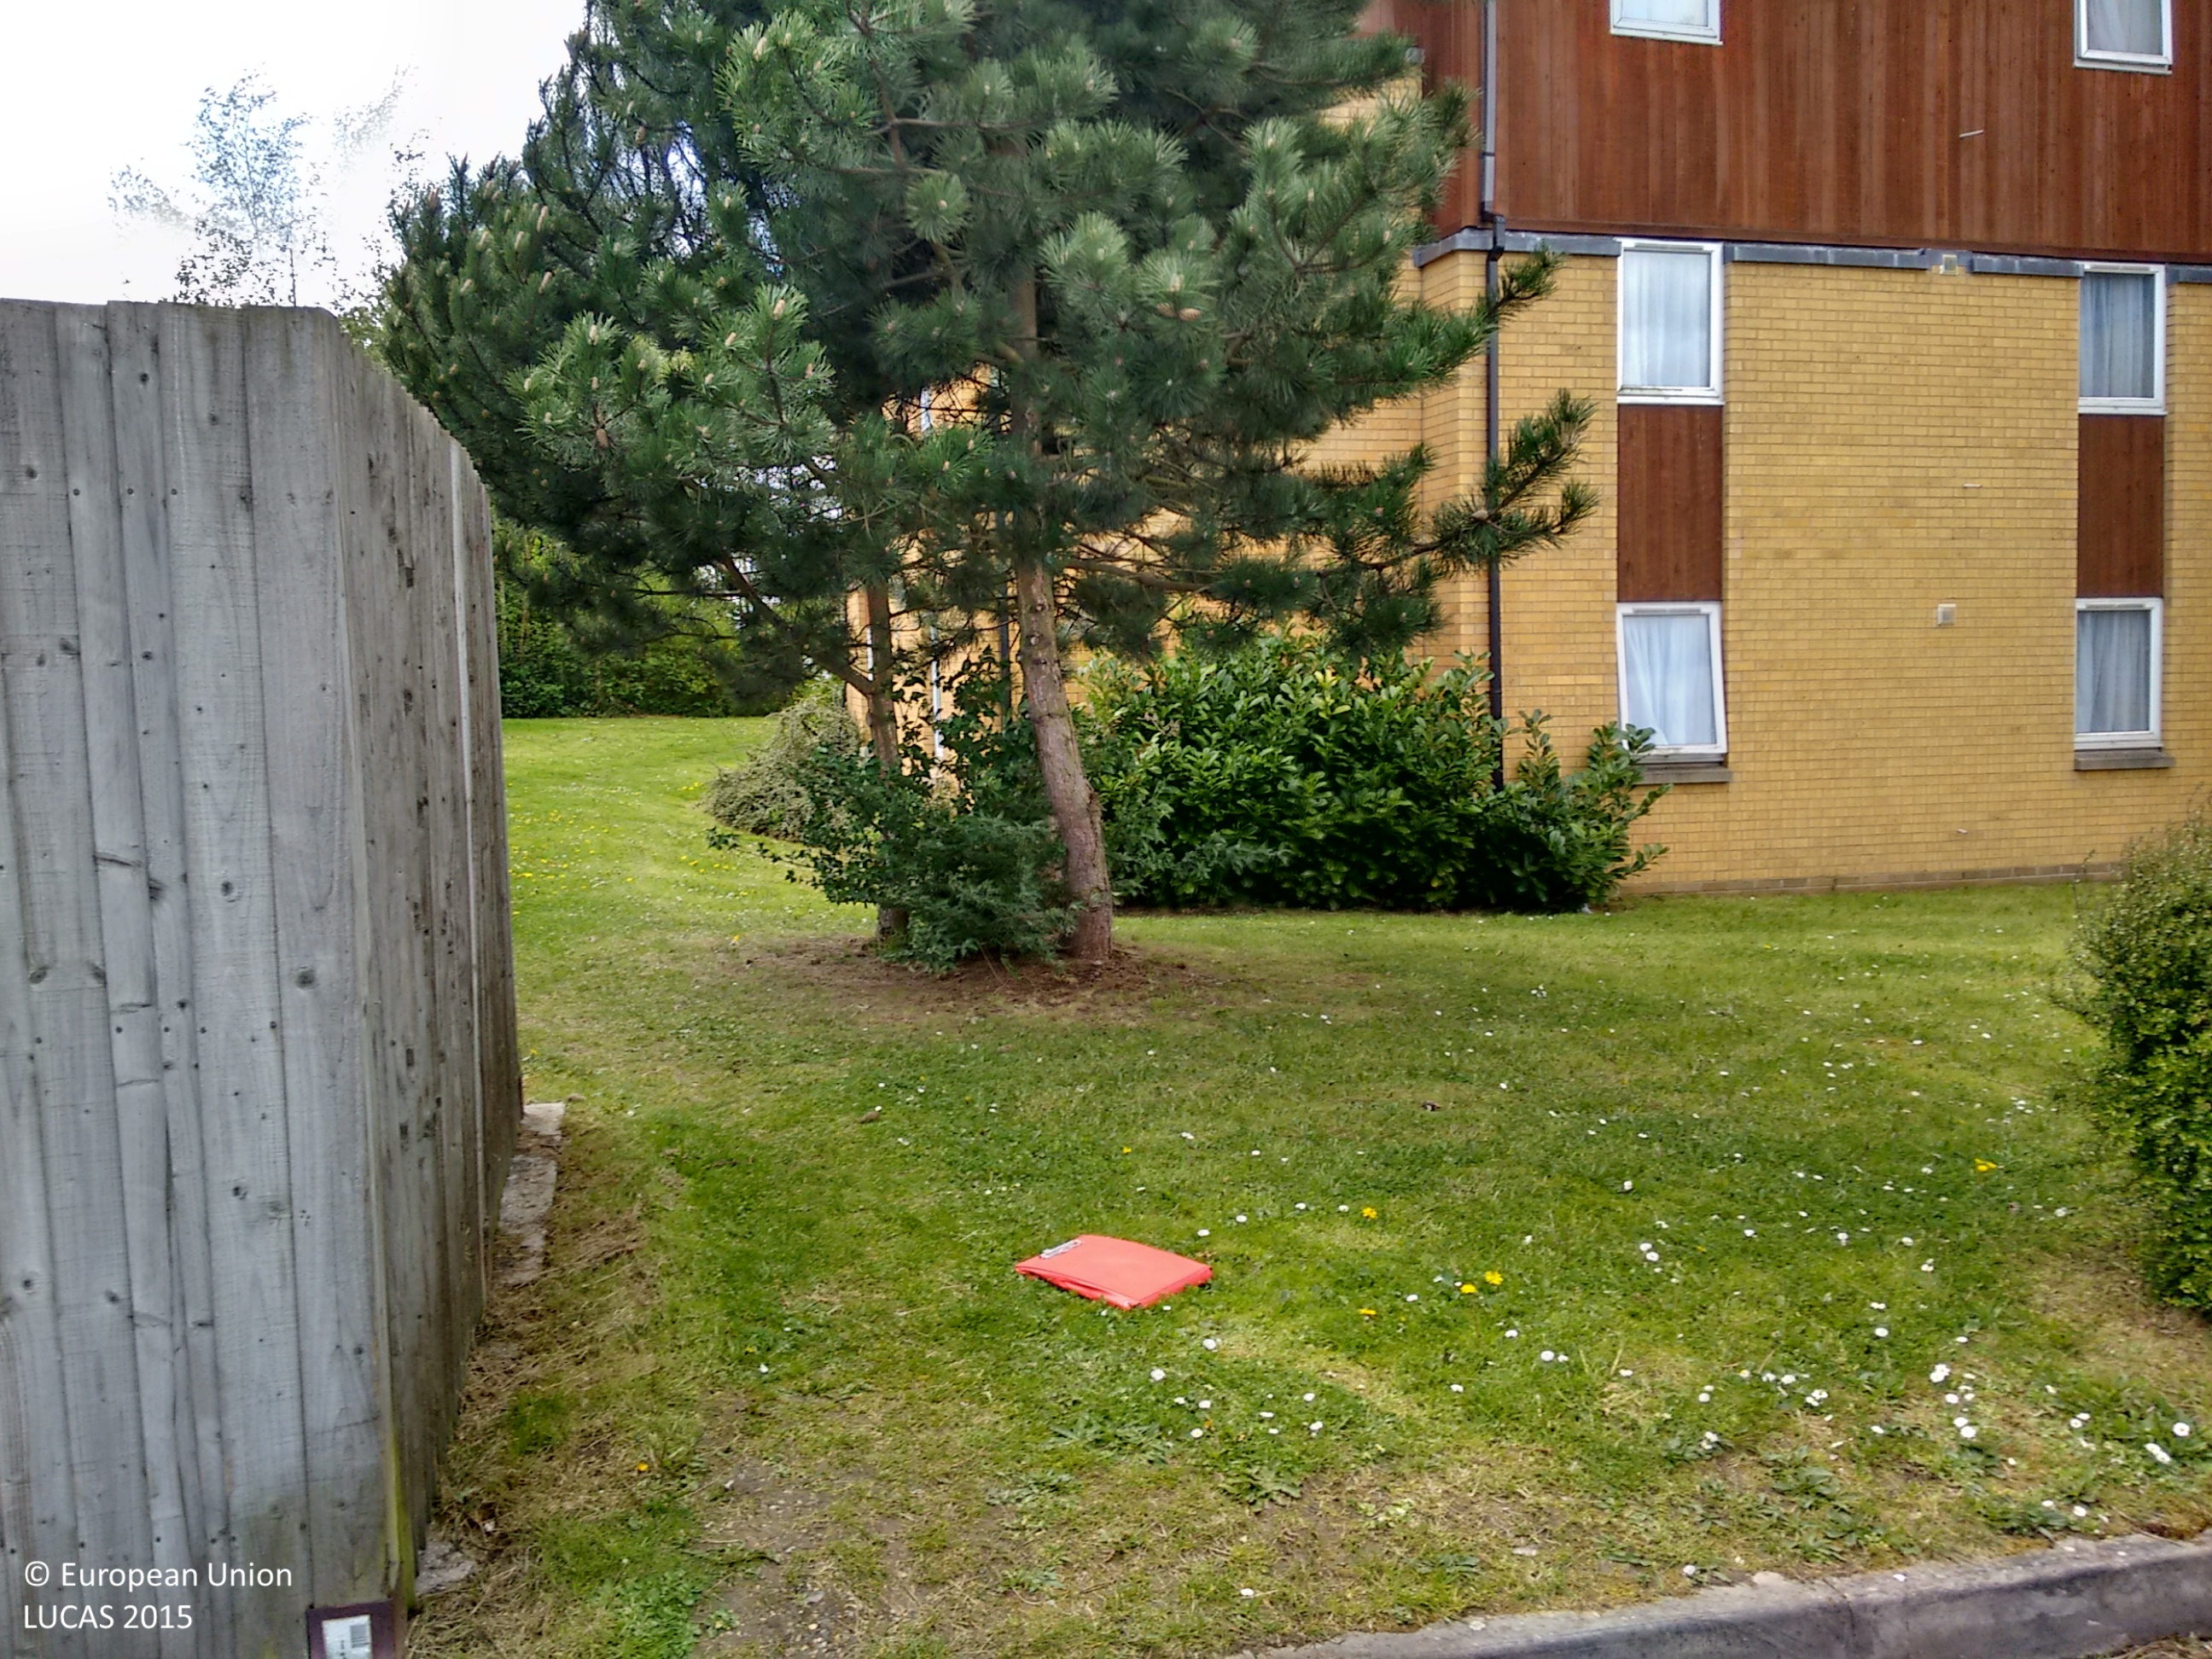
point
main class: Grassland
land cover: Grassland with sparse tree/shrub cover
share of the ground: > 75 %
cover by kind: herbaceous plants 95 %, coniferous forest trees 5 %
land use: Residential
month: May
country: GB
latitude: 51.4327
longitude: 0.2604
